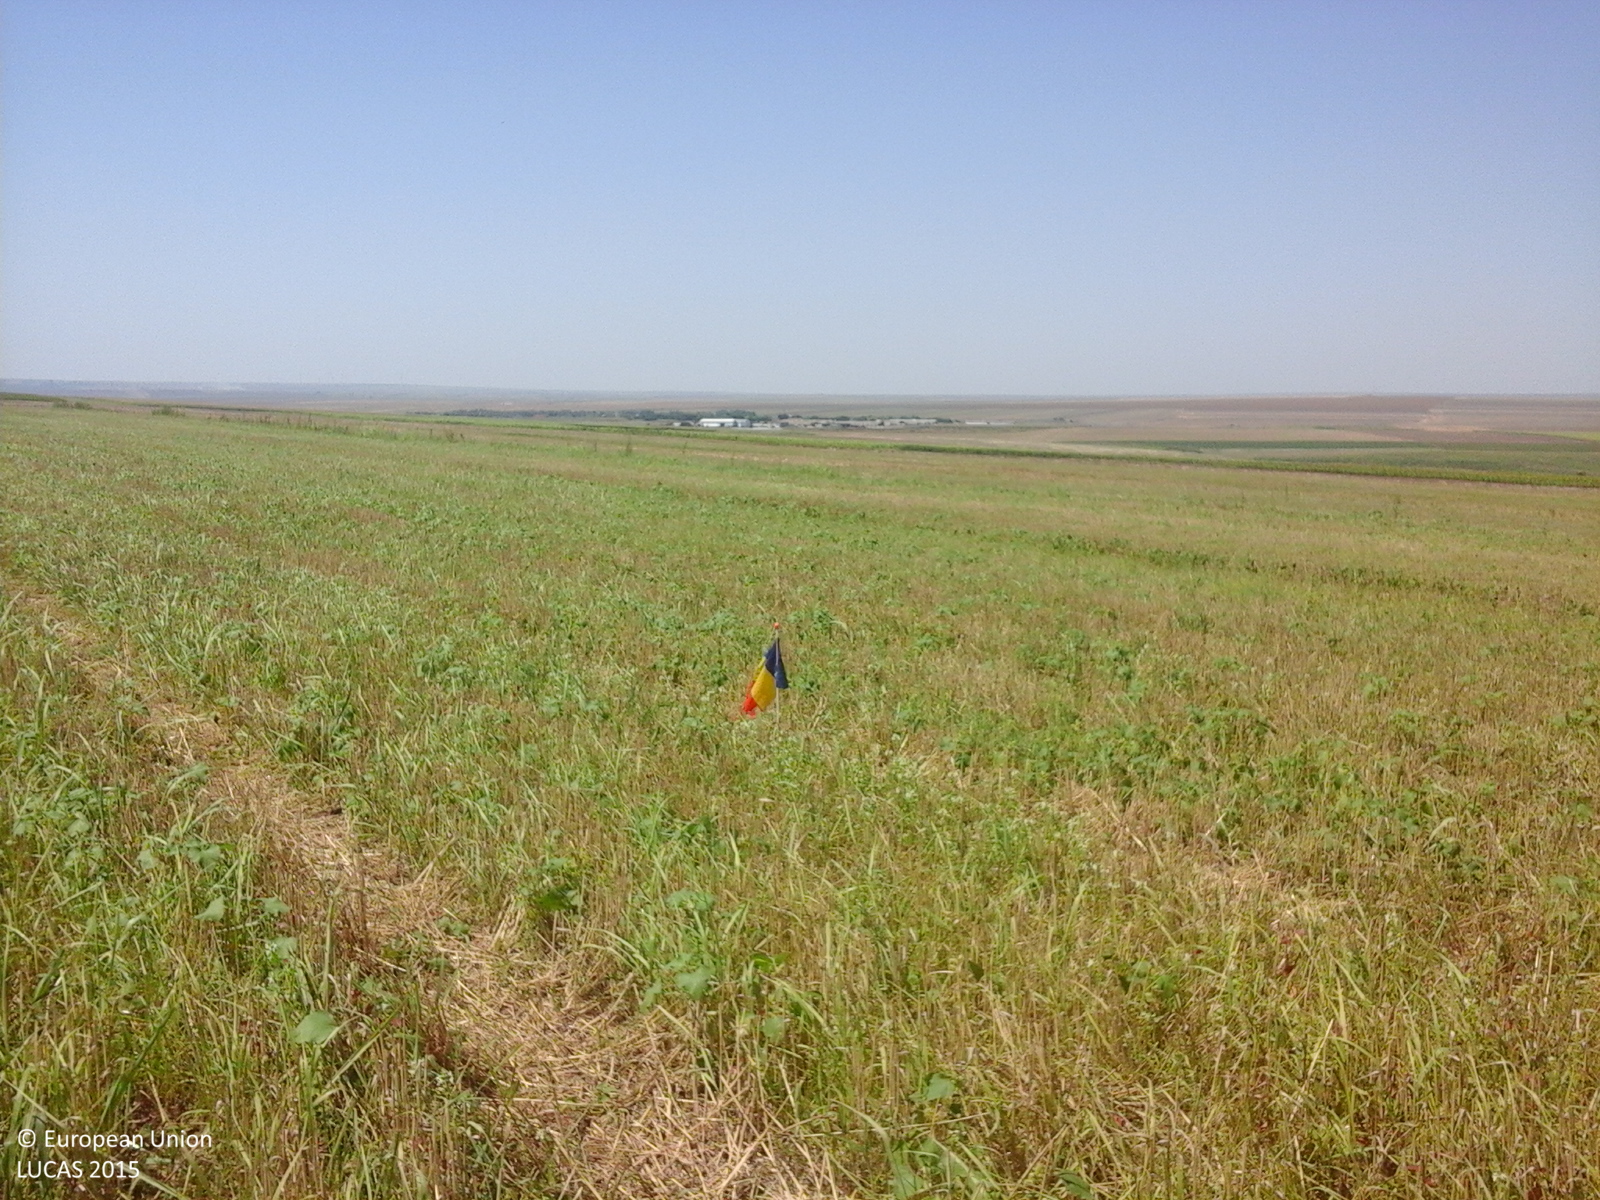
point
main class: Cropland
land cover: Common wheat
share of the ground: > 75 %
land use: Agriculture (excluding fallow land and kitchen gardens)
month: August
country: RO
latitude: 44.6285
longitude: 28.4896
